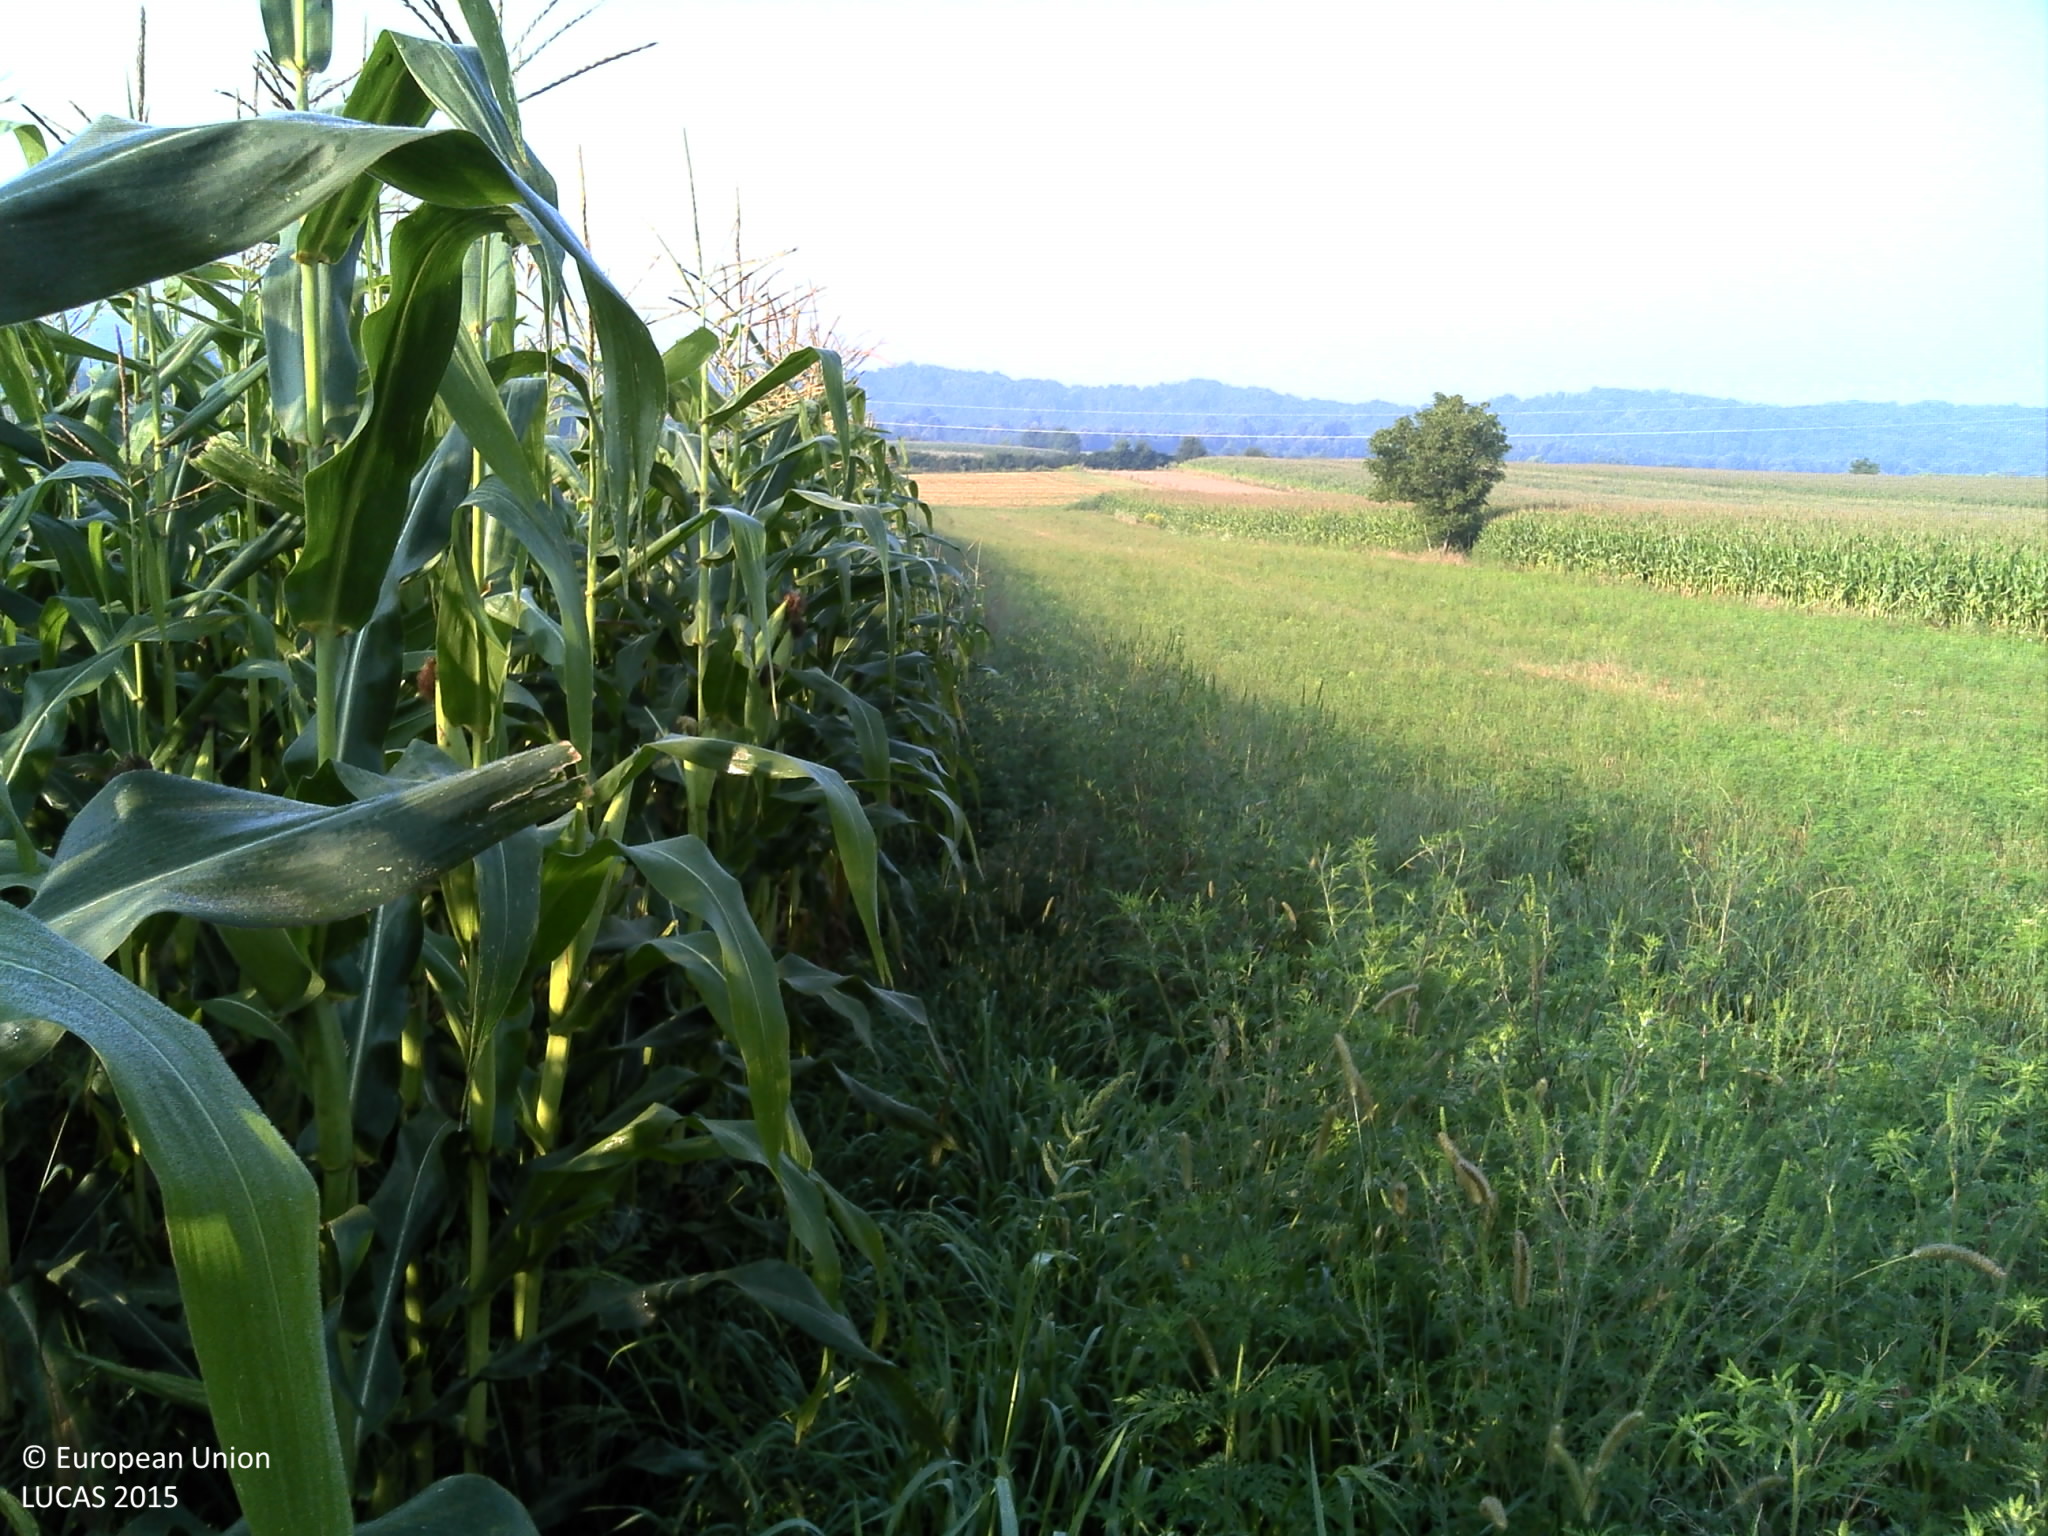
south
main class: Cropland
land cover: Maize
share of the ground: > 75 %
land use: Agriculture (excluding fallow land and kitchen gardens)
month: August
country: HR
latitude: 45.6690
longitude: 17.2793
